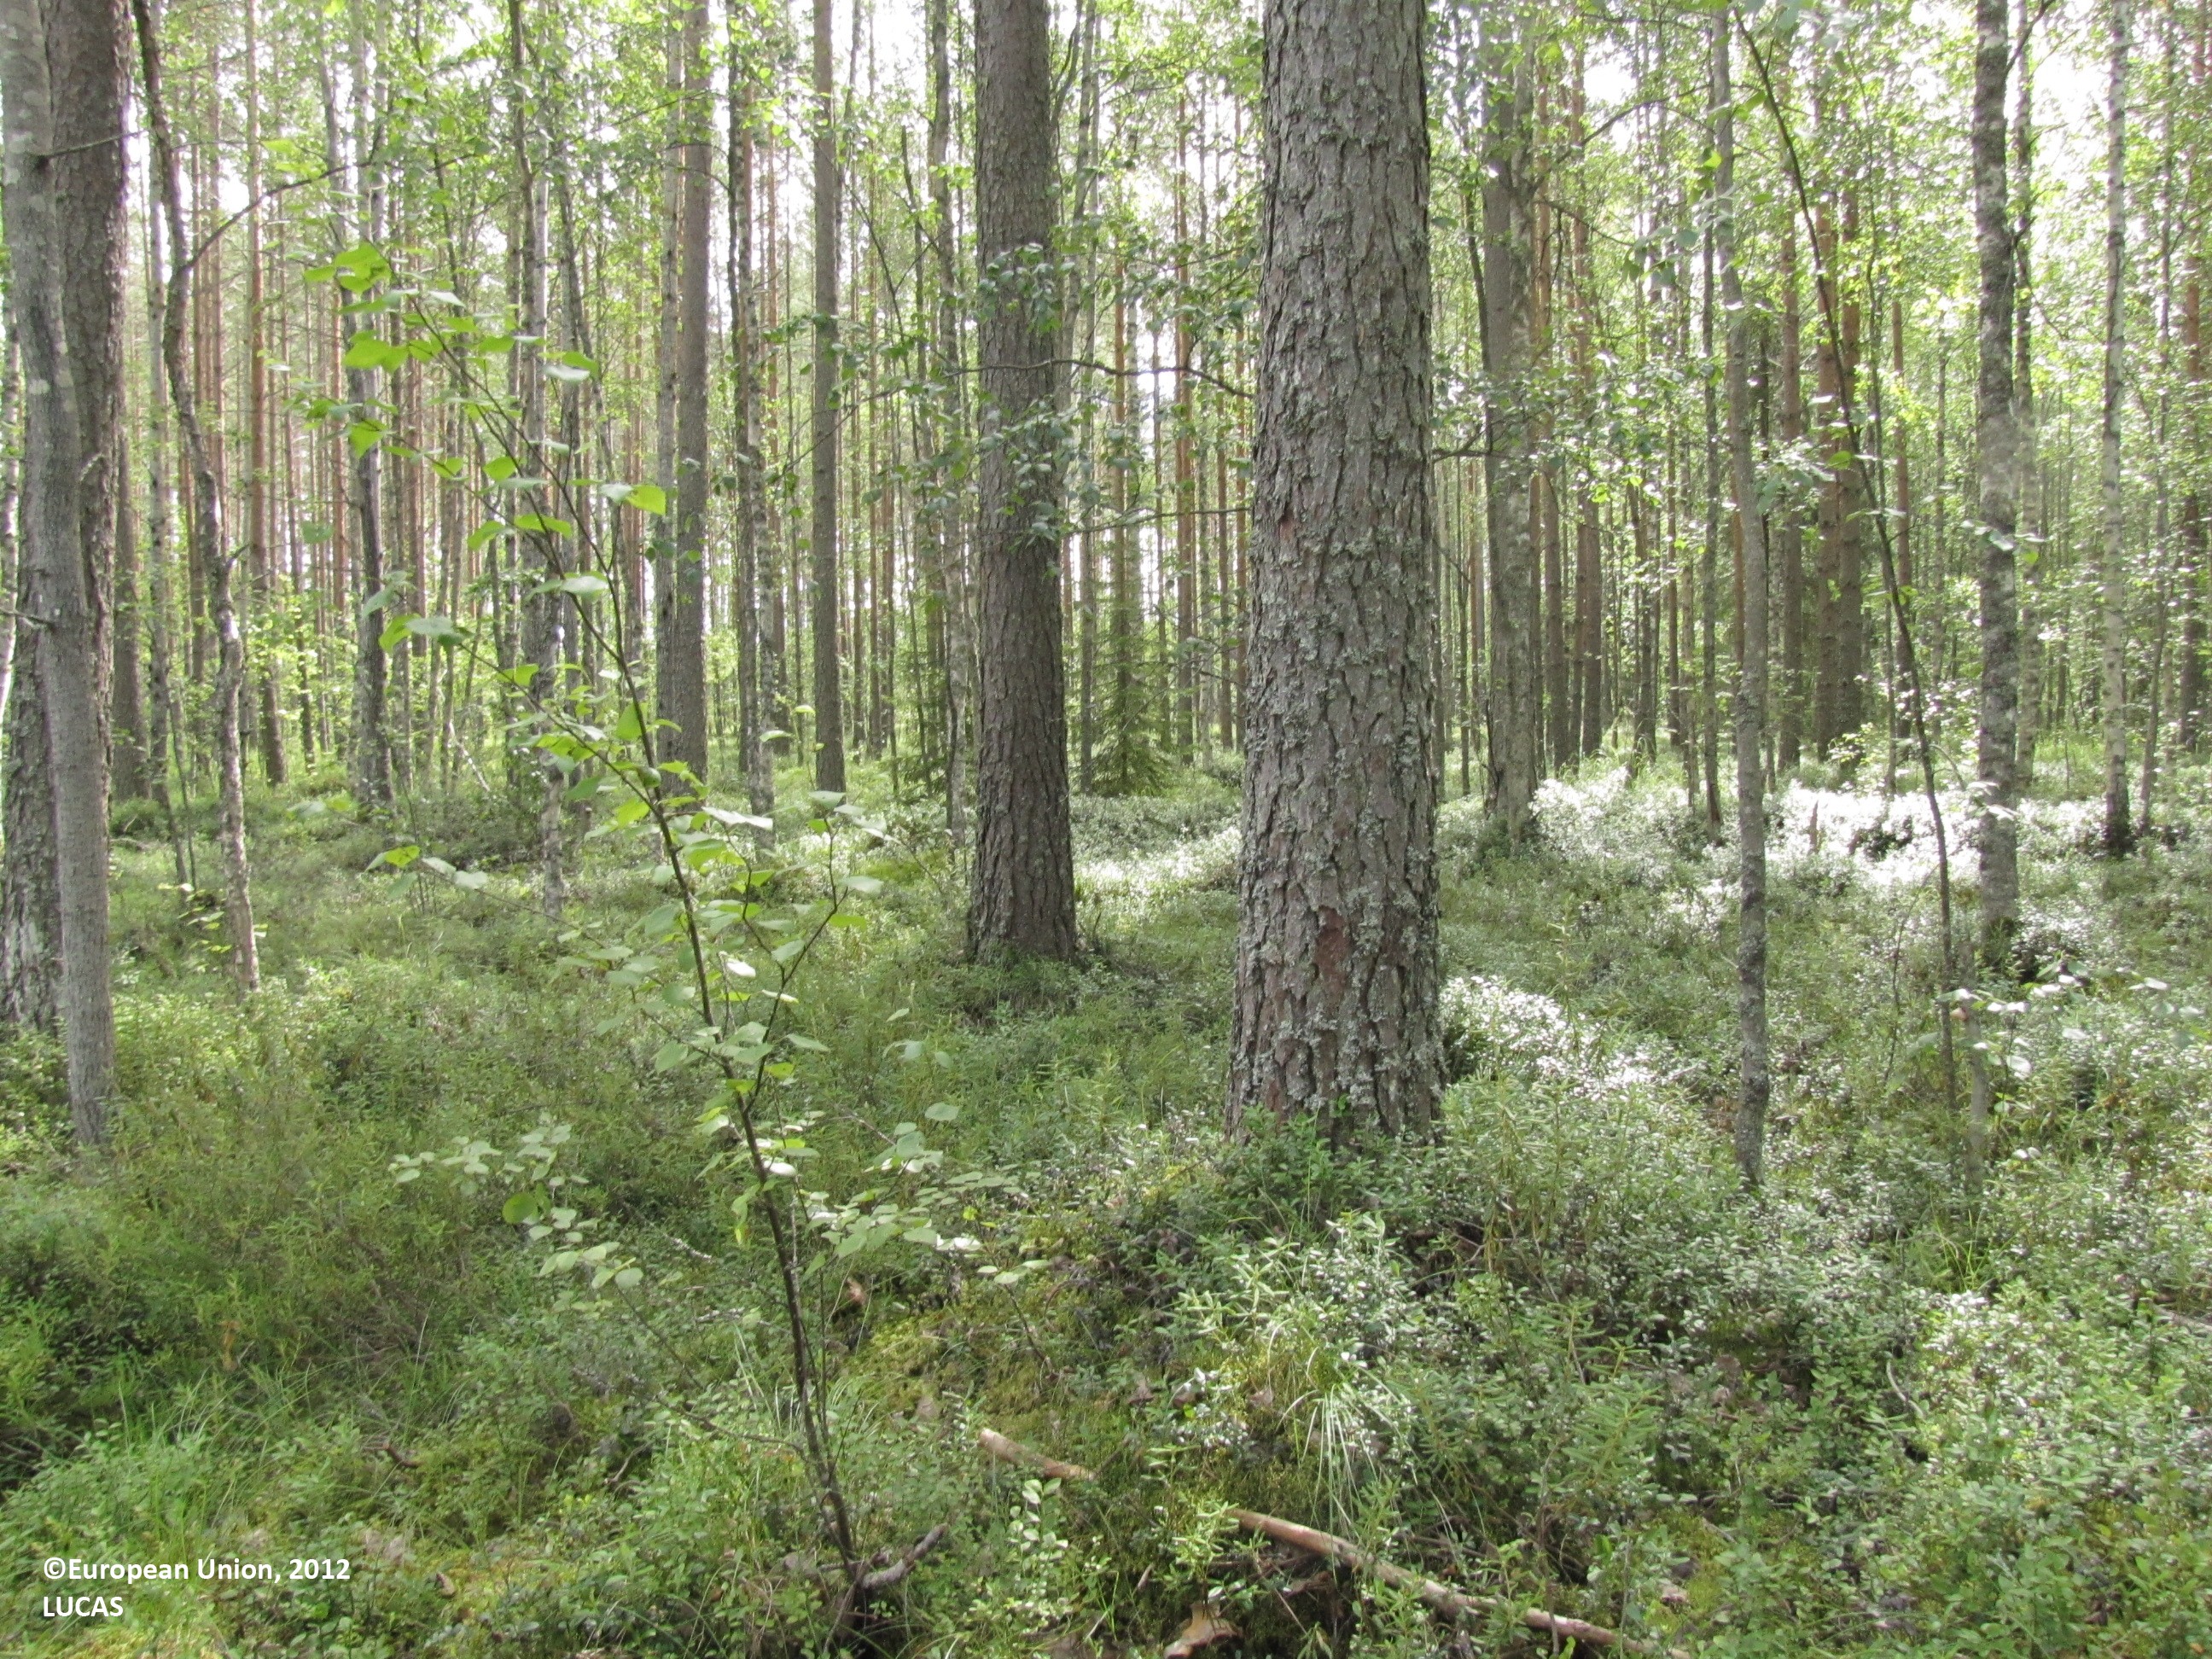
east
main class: Woodland
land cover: Pine dominated coniferous woodland
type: mire and swamp forests
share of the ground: > 75 %
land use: Forestry
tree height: > 5 m
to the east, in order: Pine dominated coniferous woodland; Pine dominated mixed woodland; Ditches and canals; Pine dominated mixed woodland; Pine dominated coniferous woodland
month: July
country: FI
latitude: 62.4087
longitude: 23.2474
